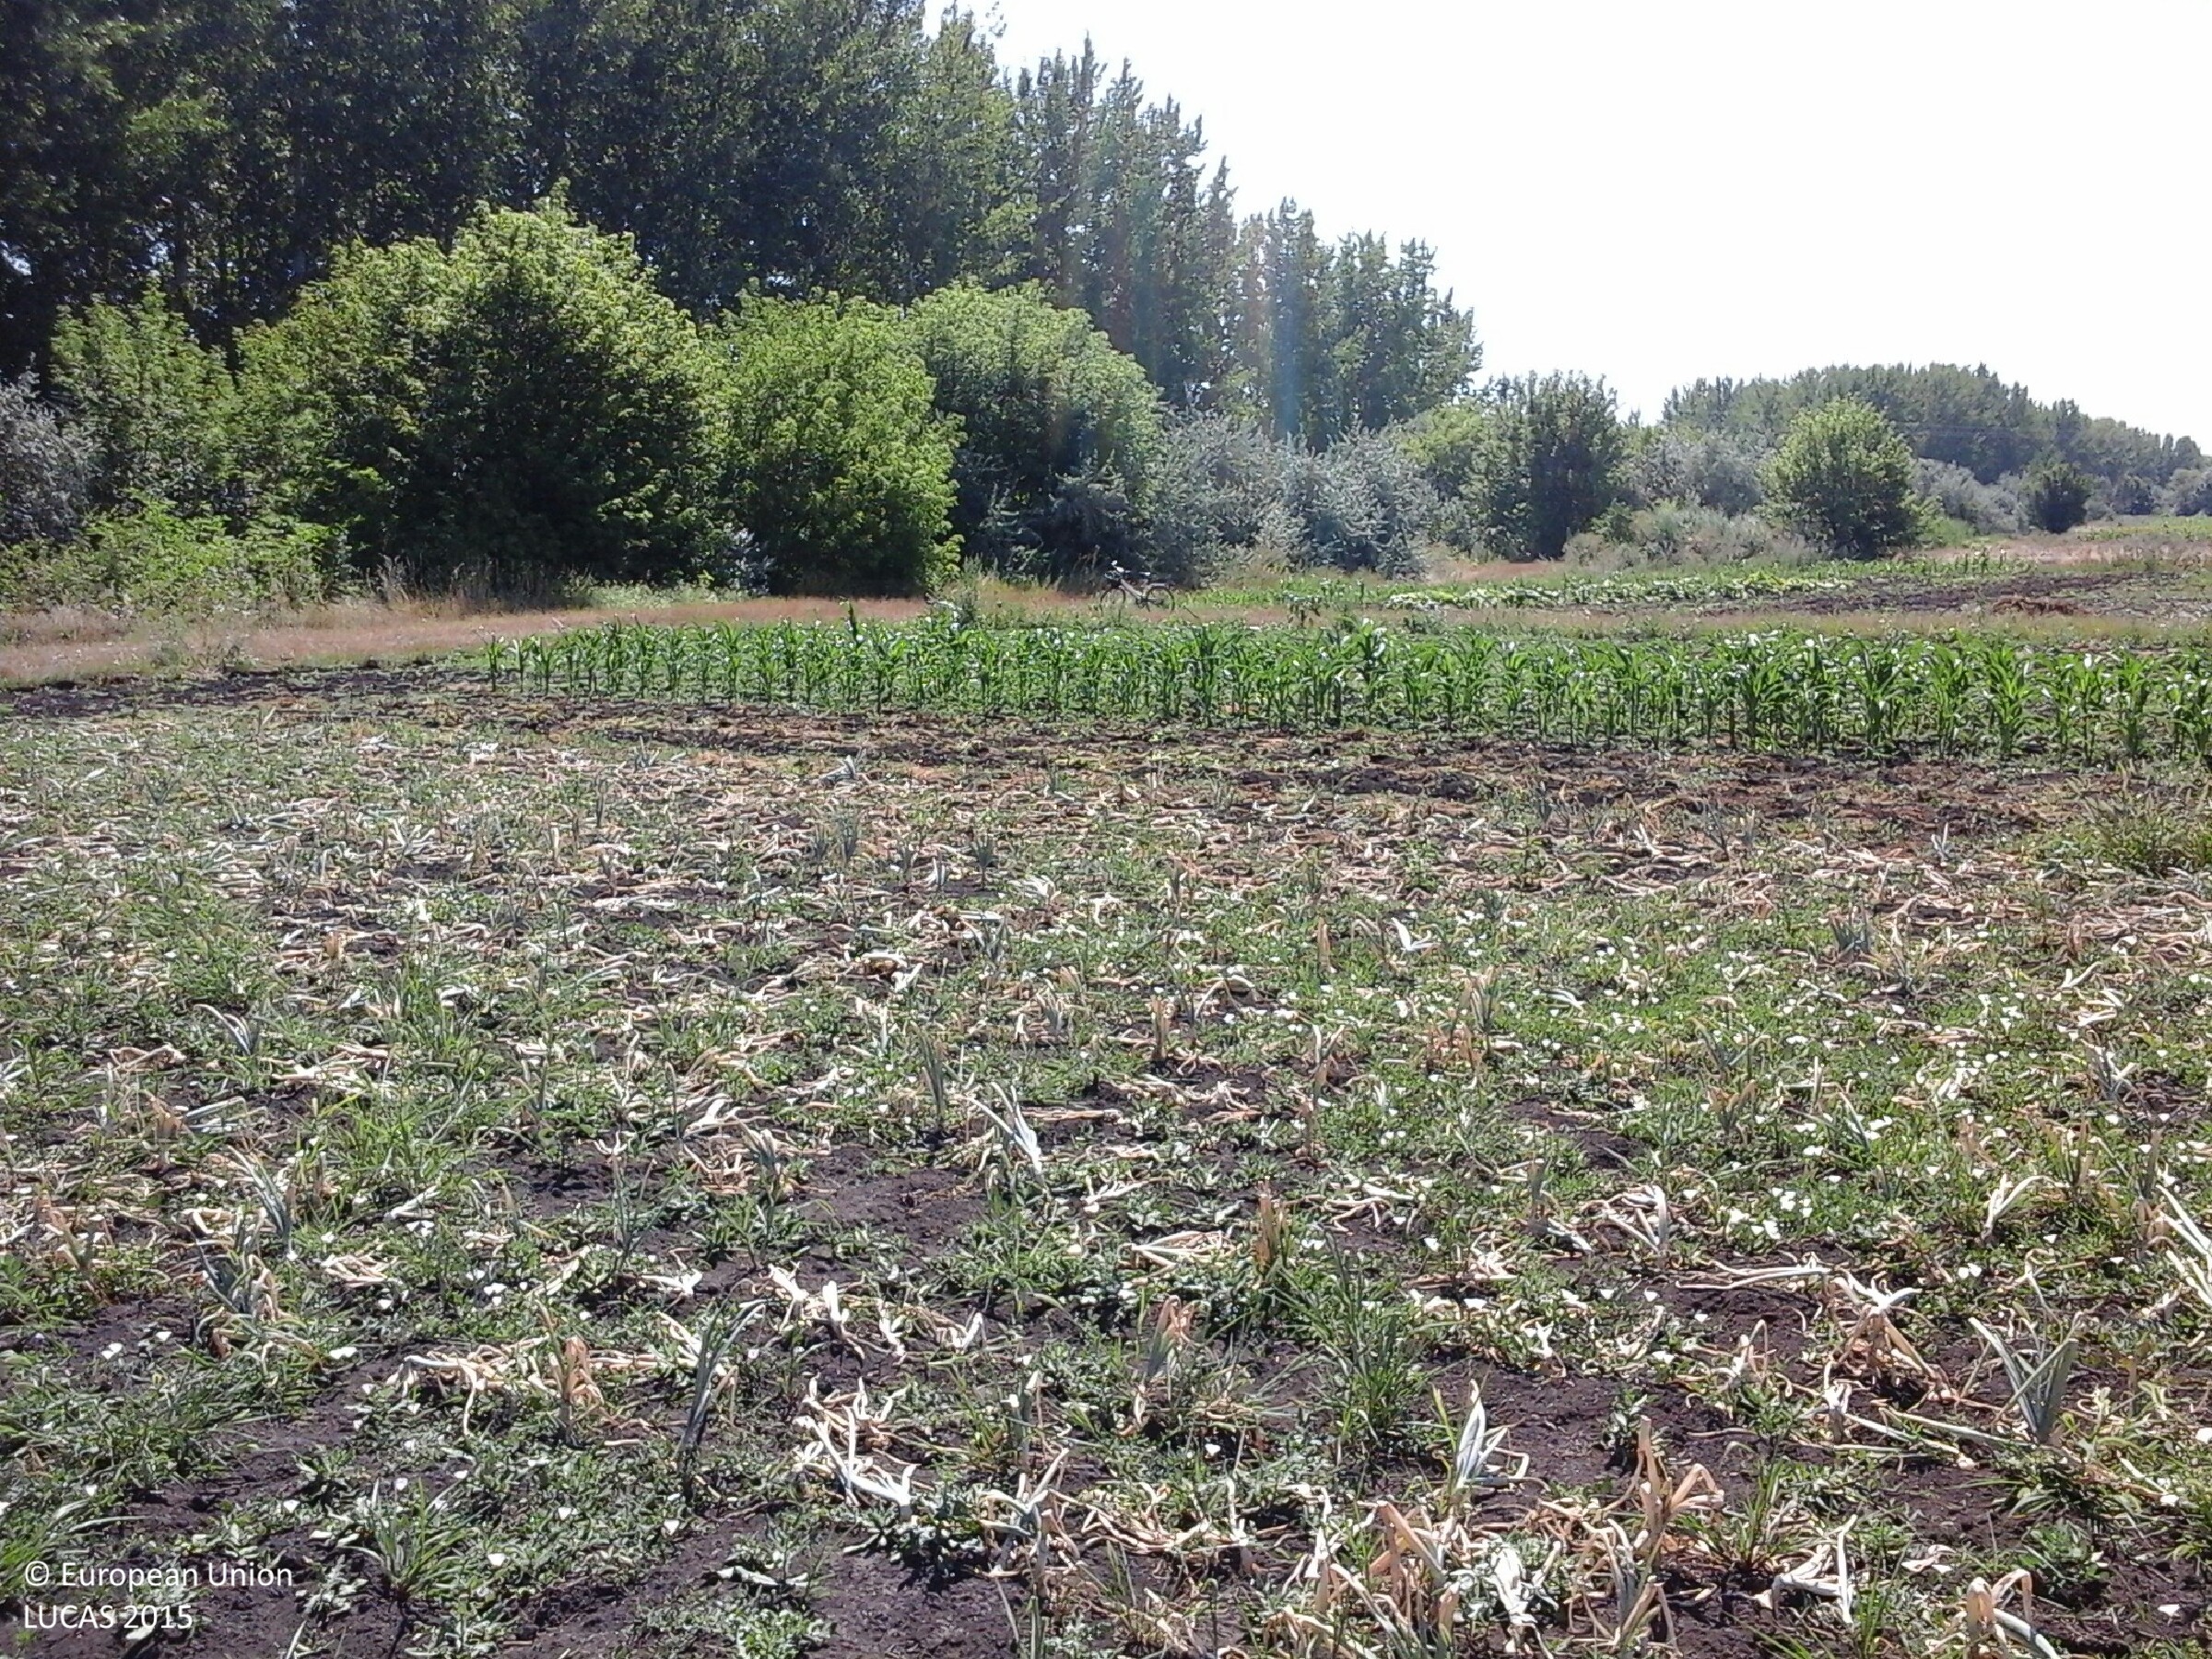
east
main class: Cropland
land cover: Other root crops
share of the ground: 25 - 50 %
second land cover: Spontaneously vegetated surfaces
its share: 25 - 50 %
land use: Agriculture (excluding fallow land and kitchen gardens)
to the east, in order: Other root crops; Spontaneously vegetated surfaces; Tracks; Broadleaved woodland; Grassland without tree/shrub cover; Grassland with sparse tree/shrub cover; Shrubland with sparse tree cover; Inland fresh running water; Broadleaved woodland; Grassland without tree/shrub cover
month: July
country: HU
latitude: 47.6218
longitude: 20.5841
